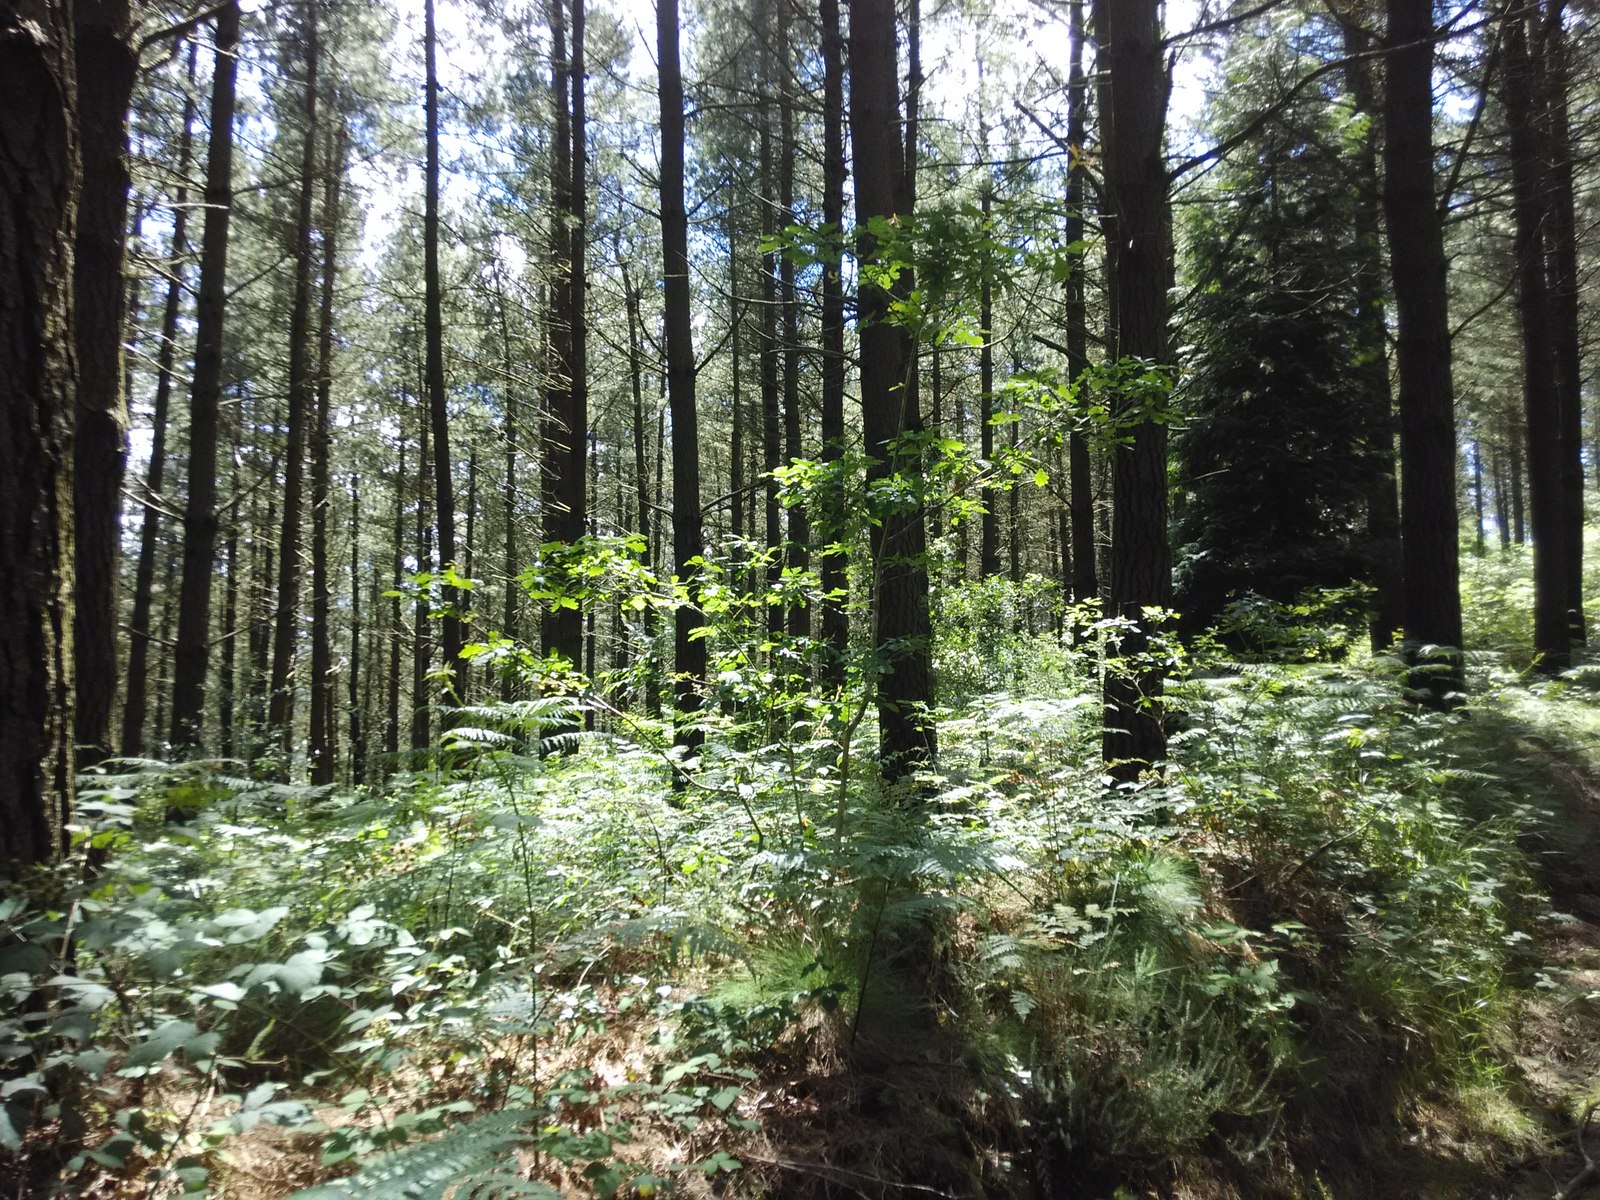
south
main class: Woodland
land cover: Pine dominated coniferous woodland
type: exotic forest
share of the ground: > 75 %
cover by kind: coniferous forest trees 100 %
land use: Forestry
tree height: > 5 m
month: July
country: ES
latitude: 43.1110
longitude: -2.5500
